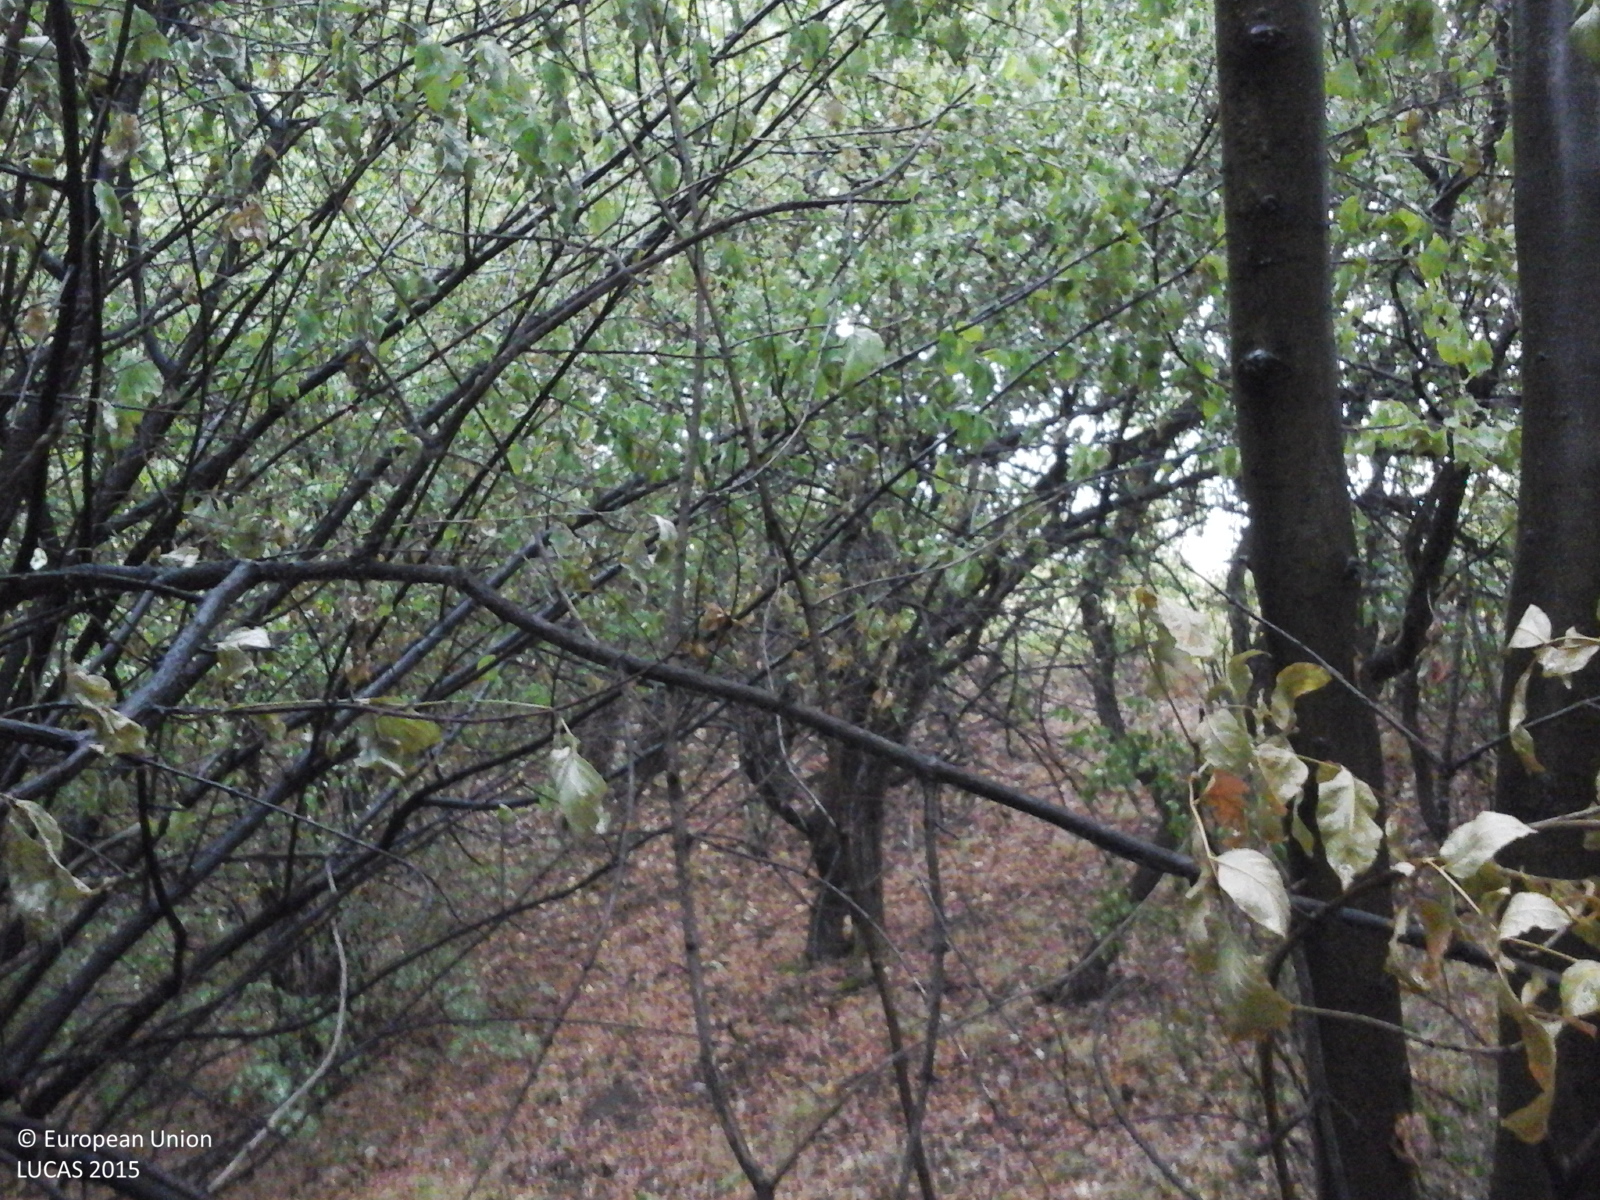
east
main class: Woodland
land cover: Broadleaved woodland
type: mesophytic deciduous forest
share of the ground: > 75 %
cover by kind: broadleaved forest trees 100 %
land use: Forestry
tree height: > 5 m
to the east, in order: Broadleaved woodland; Grassland with sparse tree/shrub cover; Grassland without tree/shrub cover; Grassland with sparse tree/shrub cover
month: August
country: RO
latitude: 44.7152
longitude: 22.7041
